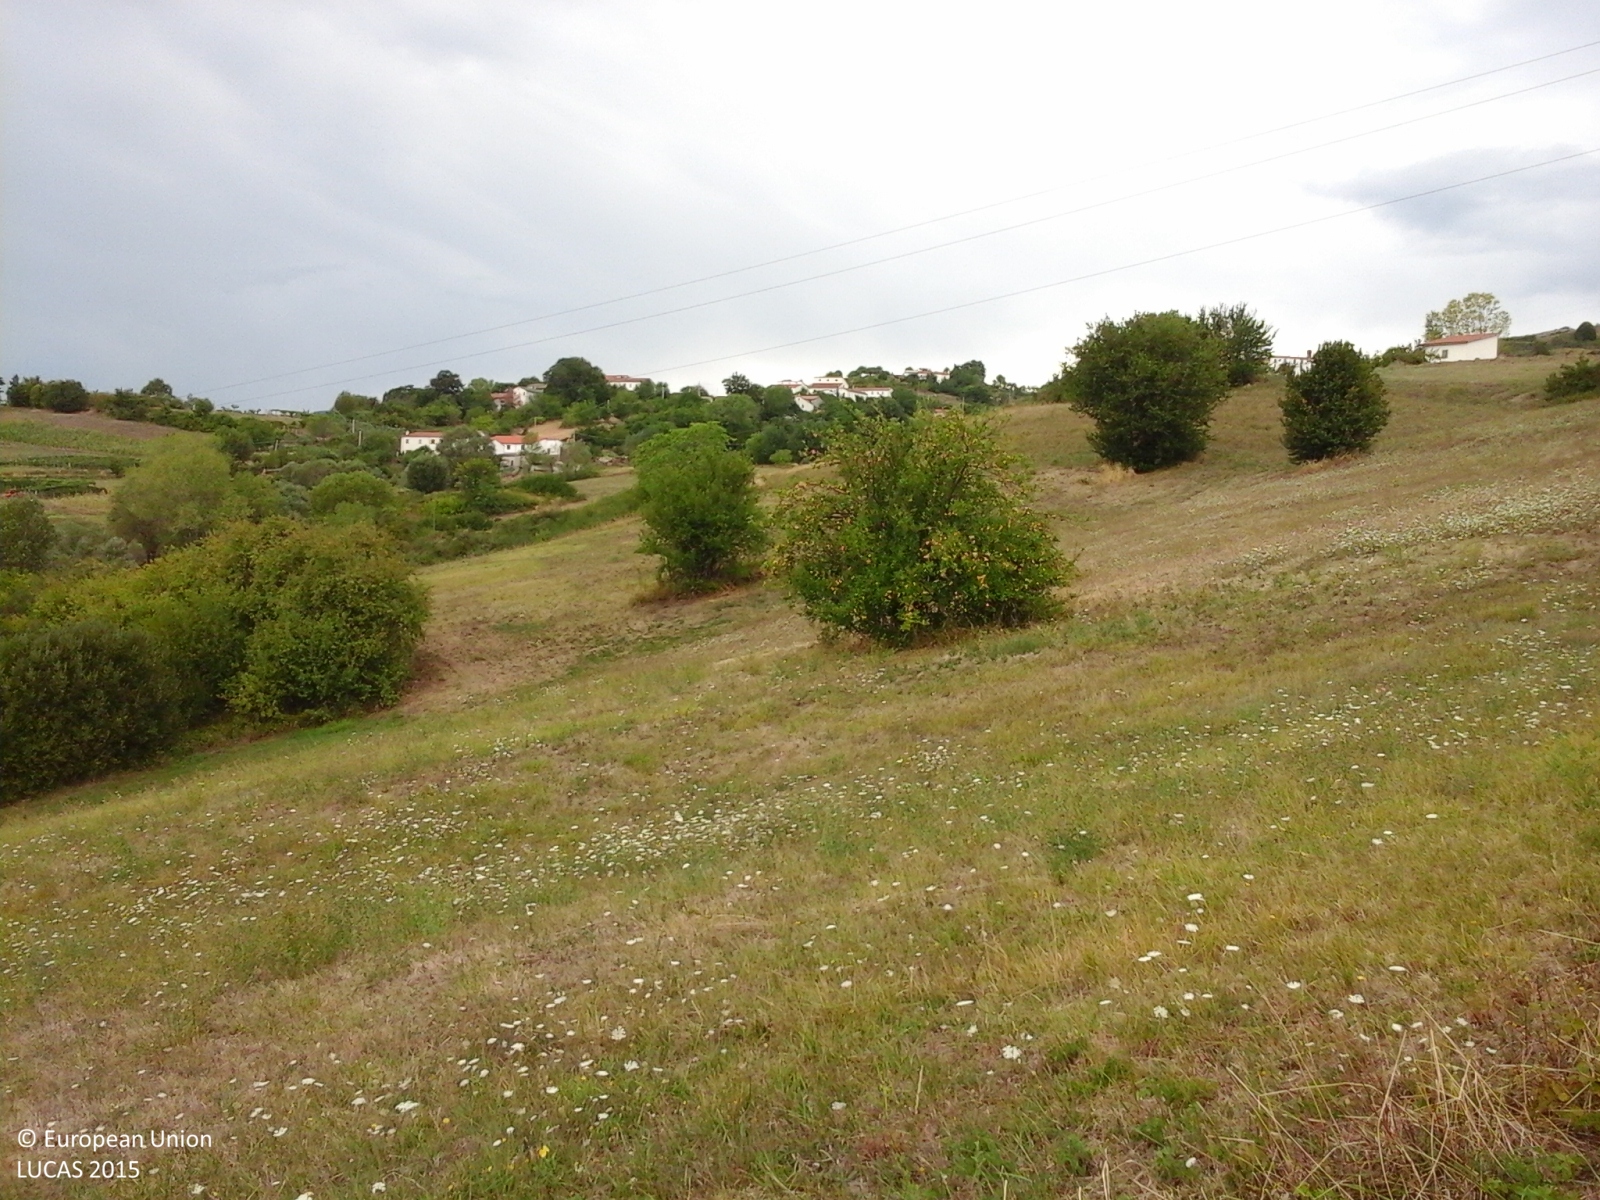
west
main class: Cropland
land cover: Temporary grasslands
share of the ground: > 75 %
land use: Agriculture (excluding fallow land and kitchen gardens)
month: August
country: IT
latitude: 41.8346
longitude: 14.4045
